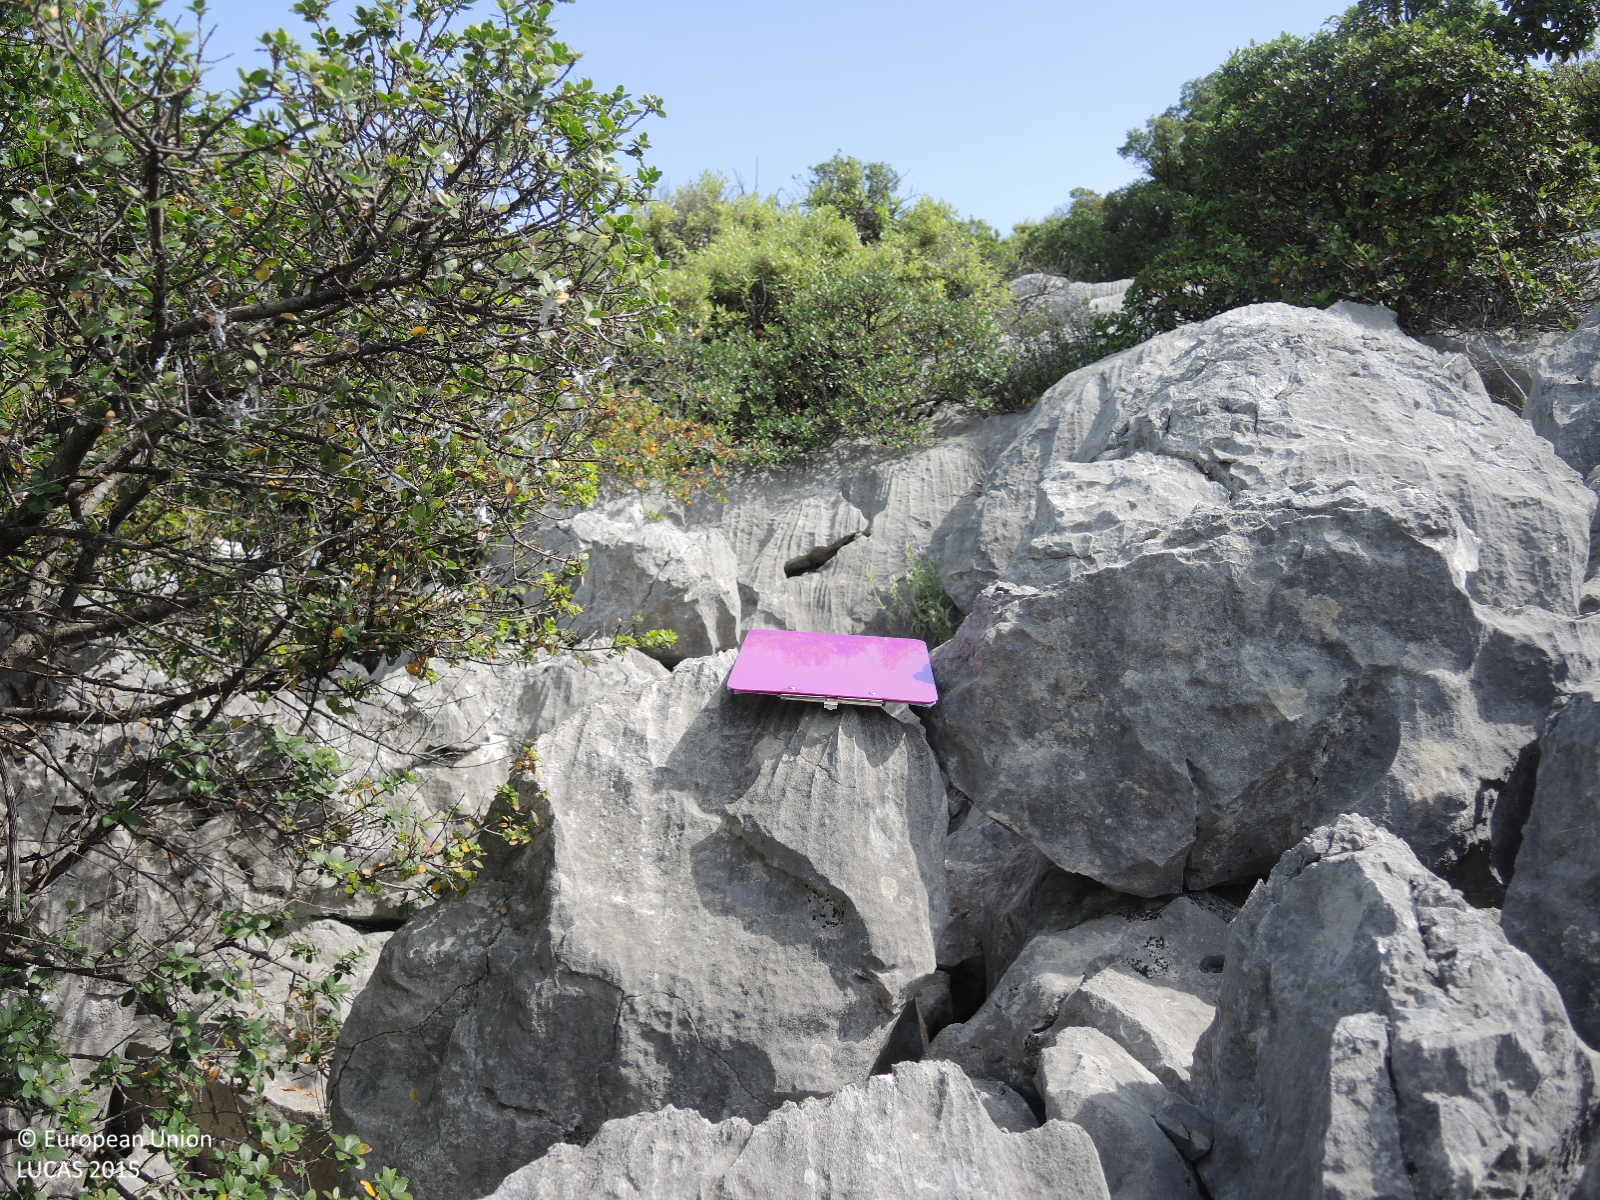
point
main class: Shrubland
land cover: Shrubland without tree cover
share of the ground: 50 - 75 %
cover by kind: shrubs 55 %, unconsolidated bare surface 40 %, consolidated bare surface 5 %
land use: Semi-natural and natural areas not in use
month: May
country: HR
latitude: 43.8683
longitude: 15.7029
